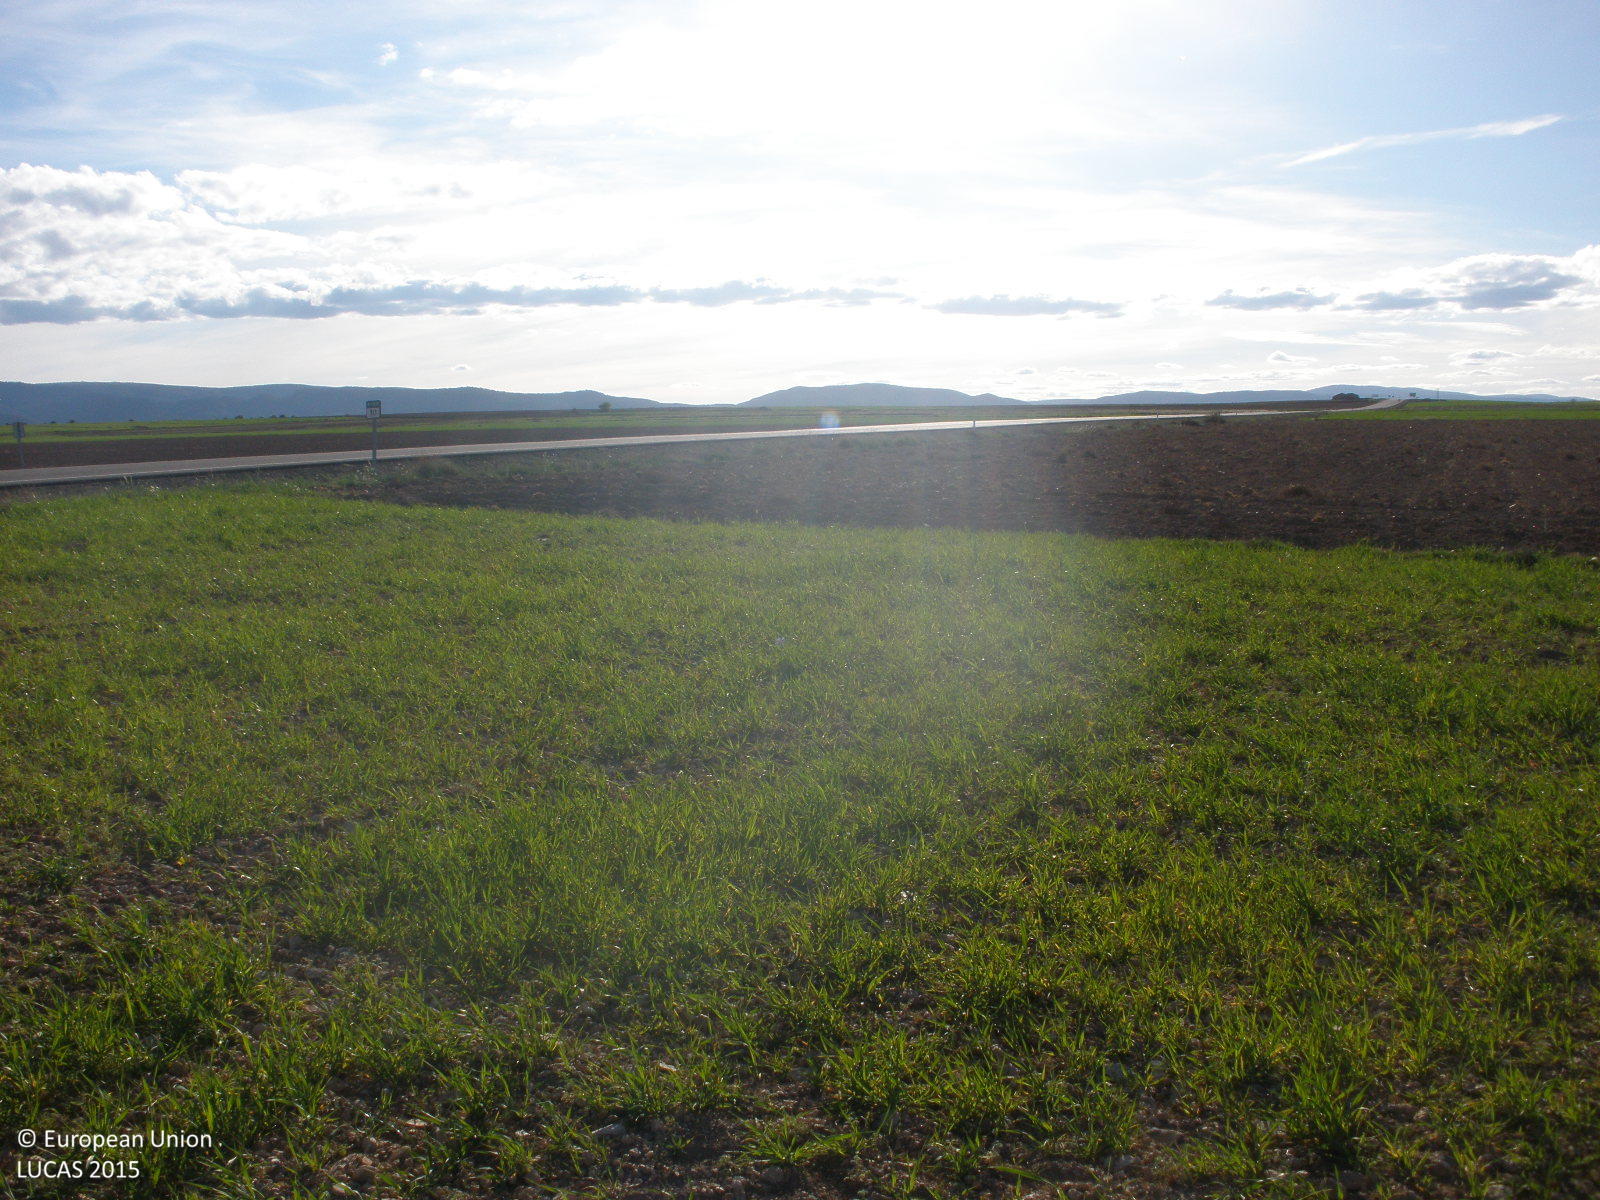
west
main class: Cropland
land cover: Barley
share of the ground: 50 - 75 %
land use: Agriculture (excluding fallow land and kitchen gardens)
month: April
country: ES
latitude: 40.4163
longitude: -1.2911
